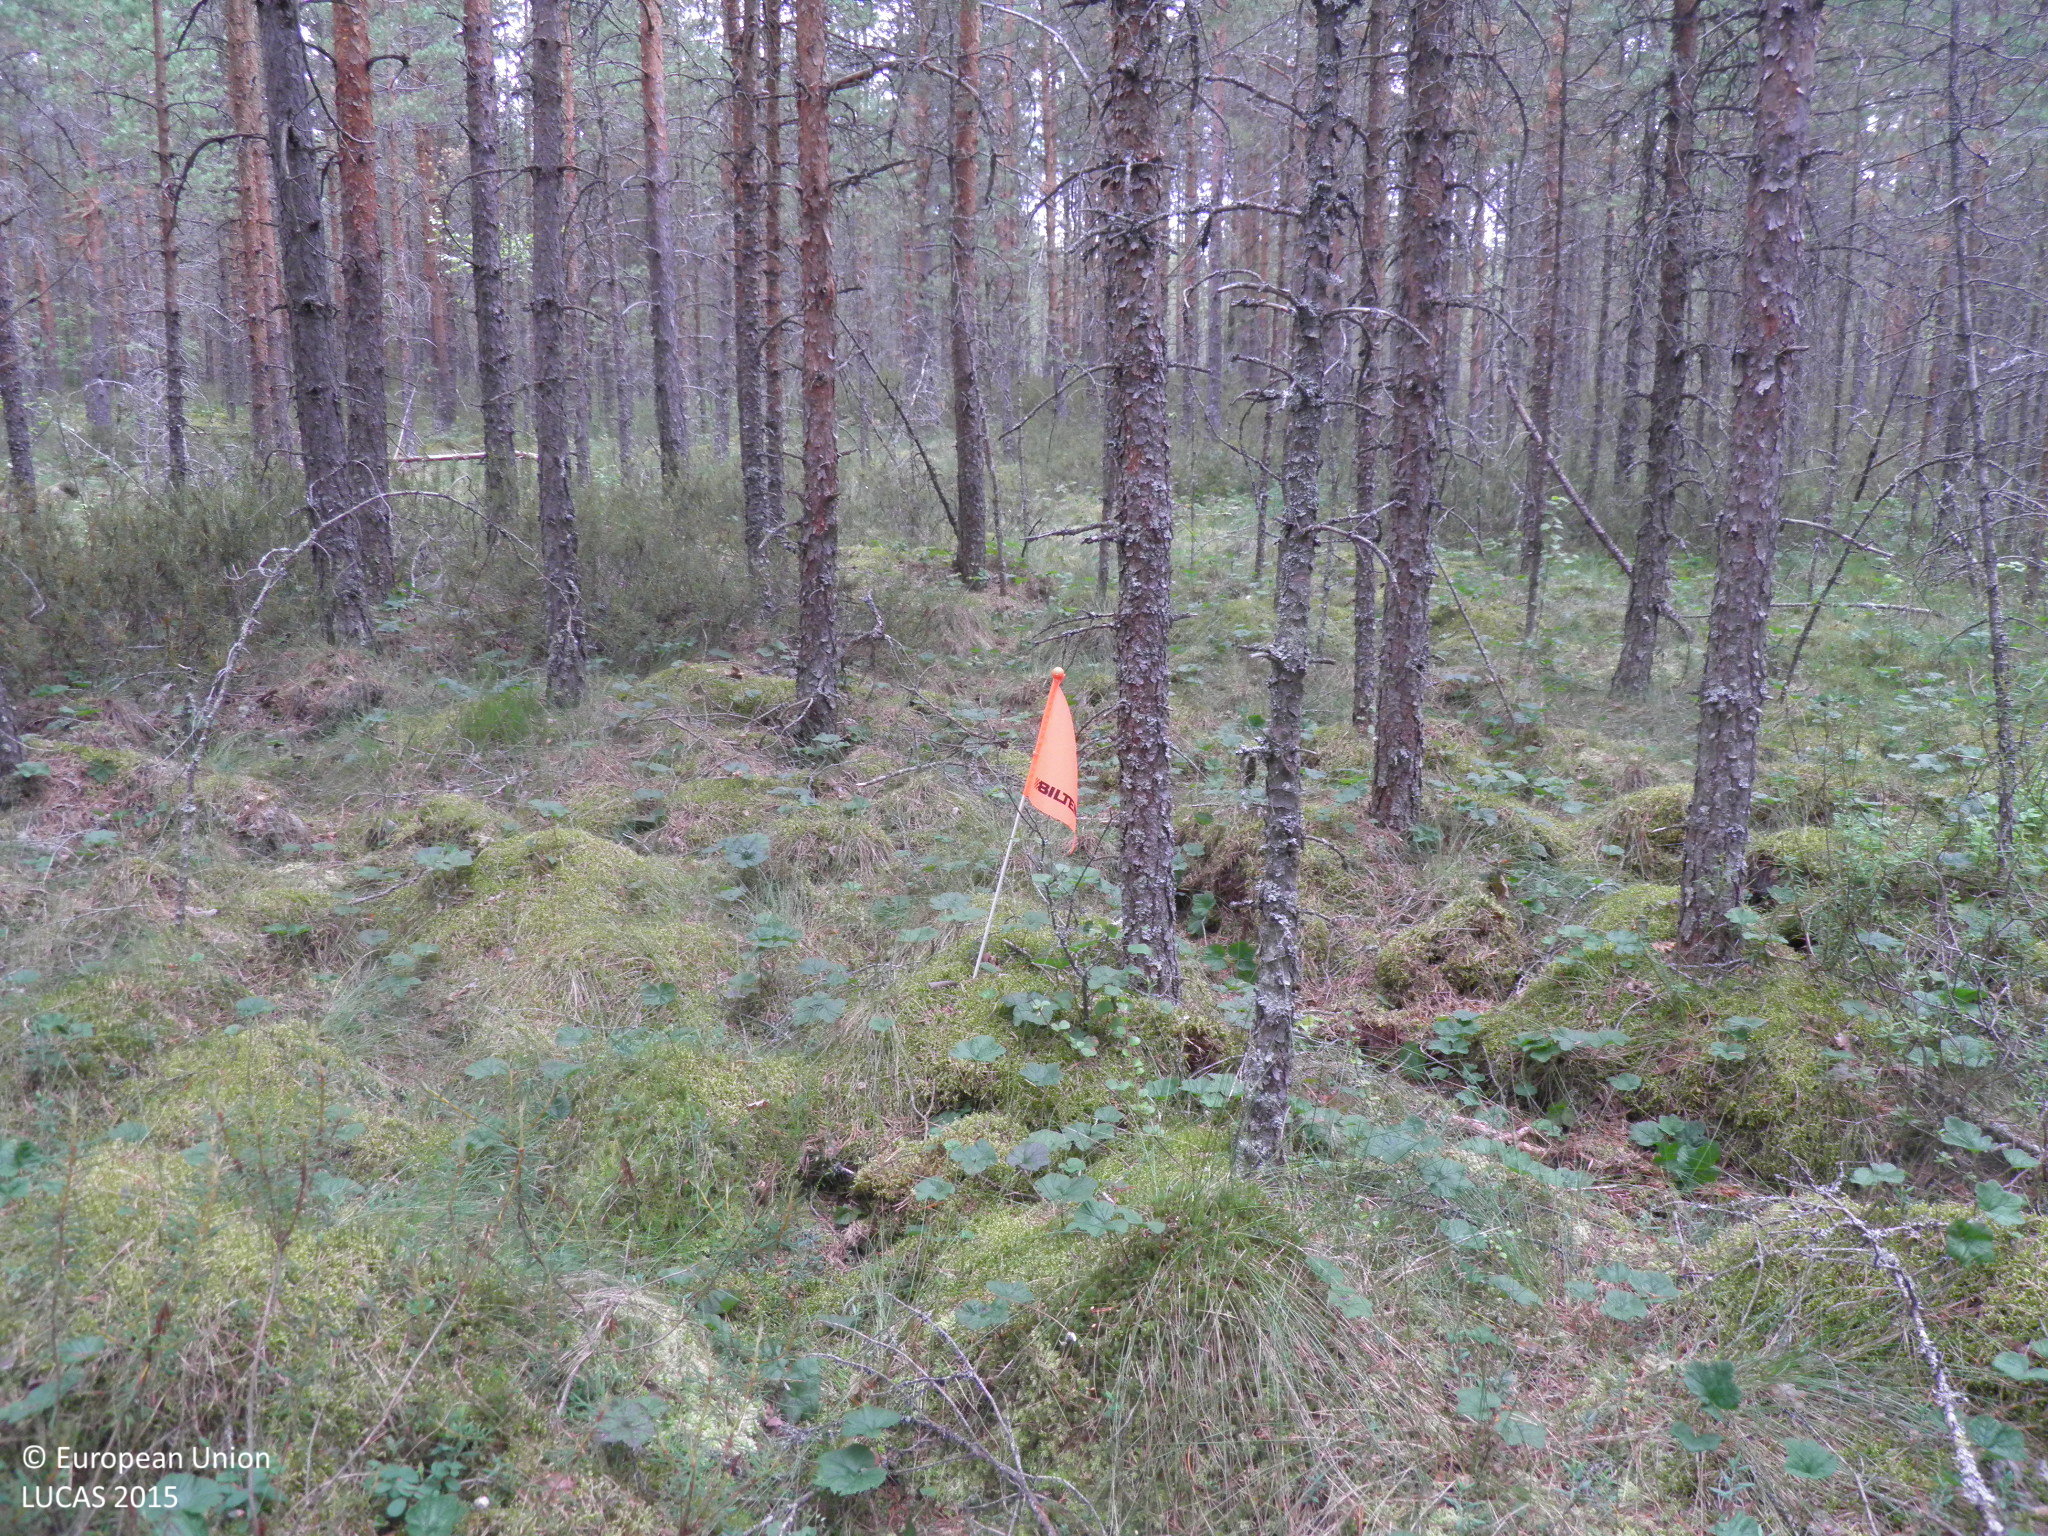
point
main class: Woodland
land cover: Pine dominated coniferous woodland
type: mire and swamp forests
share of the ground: 50 - 75 %
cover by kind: coniferous forest trees 50 %, shrubs 25 %, lichens and mosses 25 %
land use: Forestry
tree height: > 5 m
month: August
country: FI
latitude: 61.0617
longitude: 22.9495
